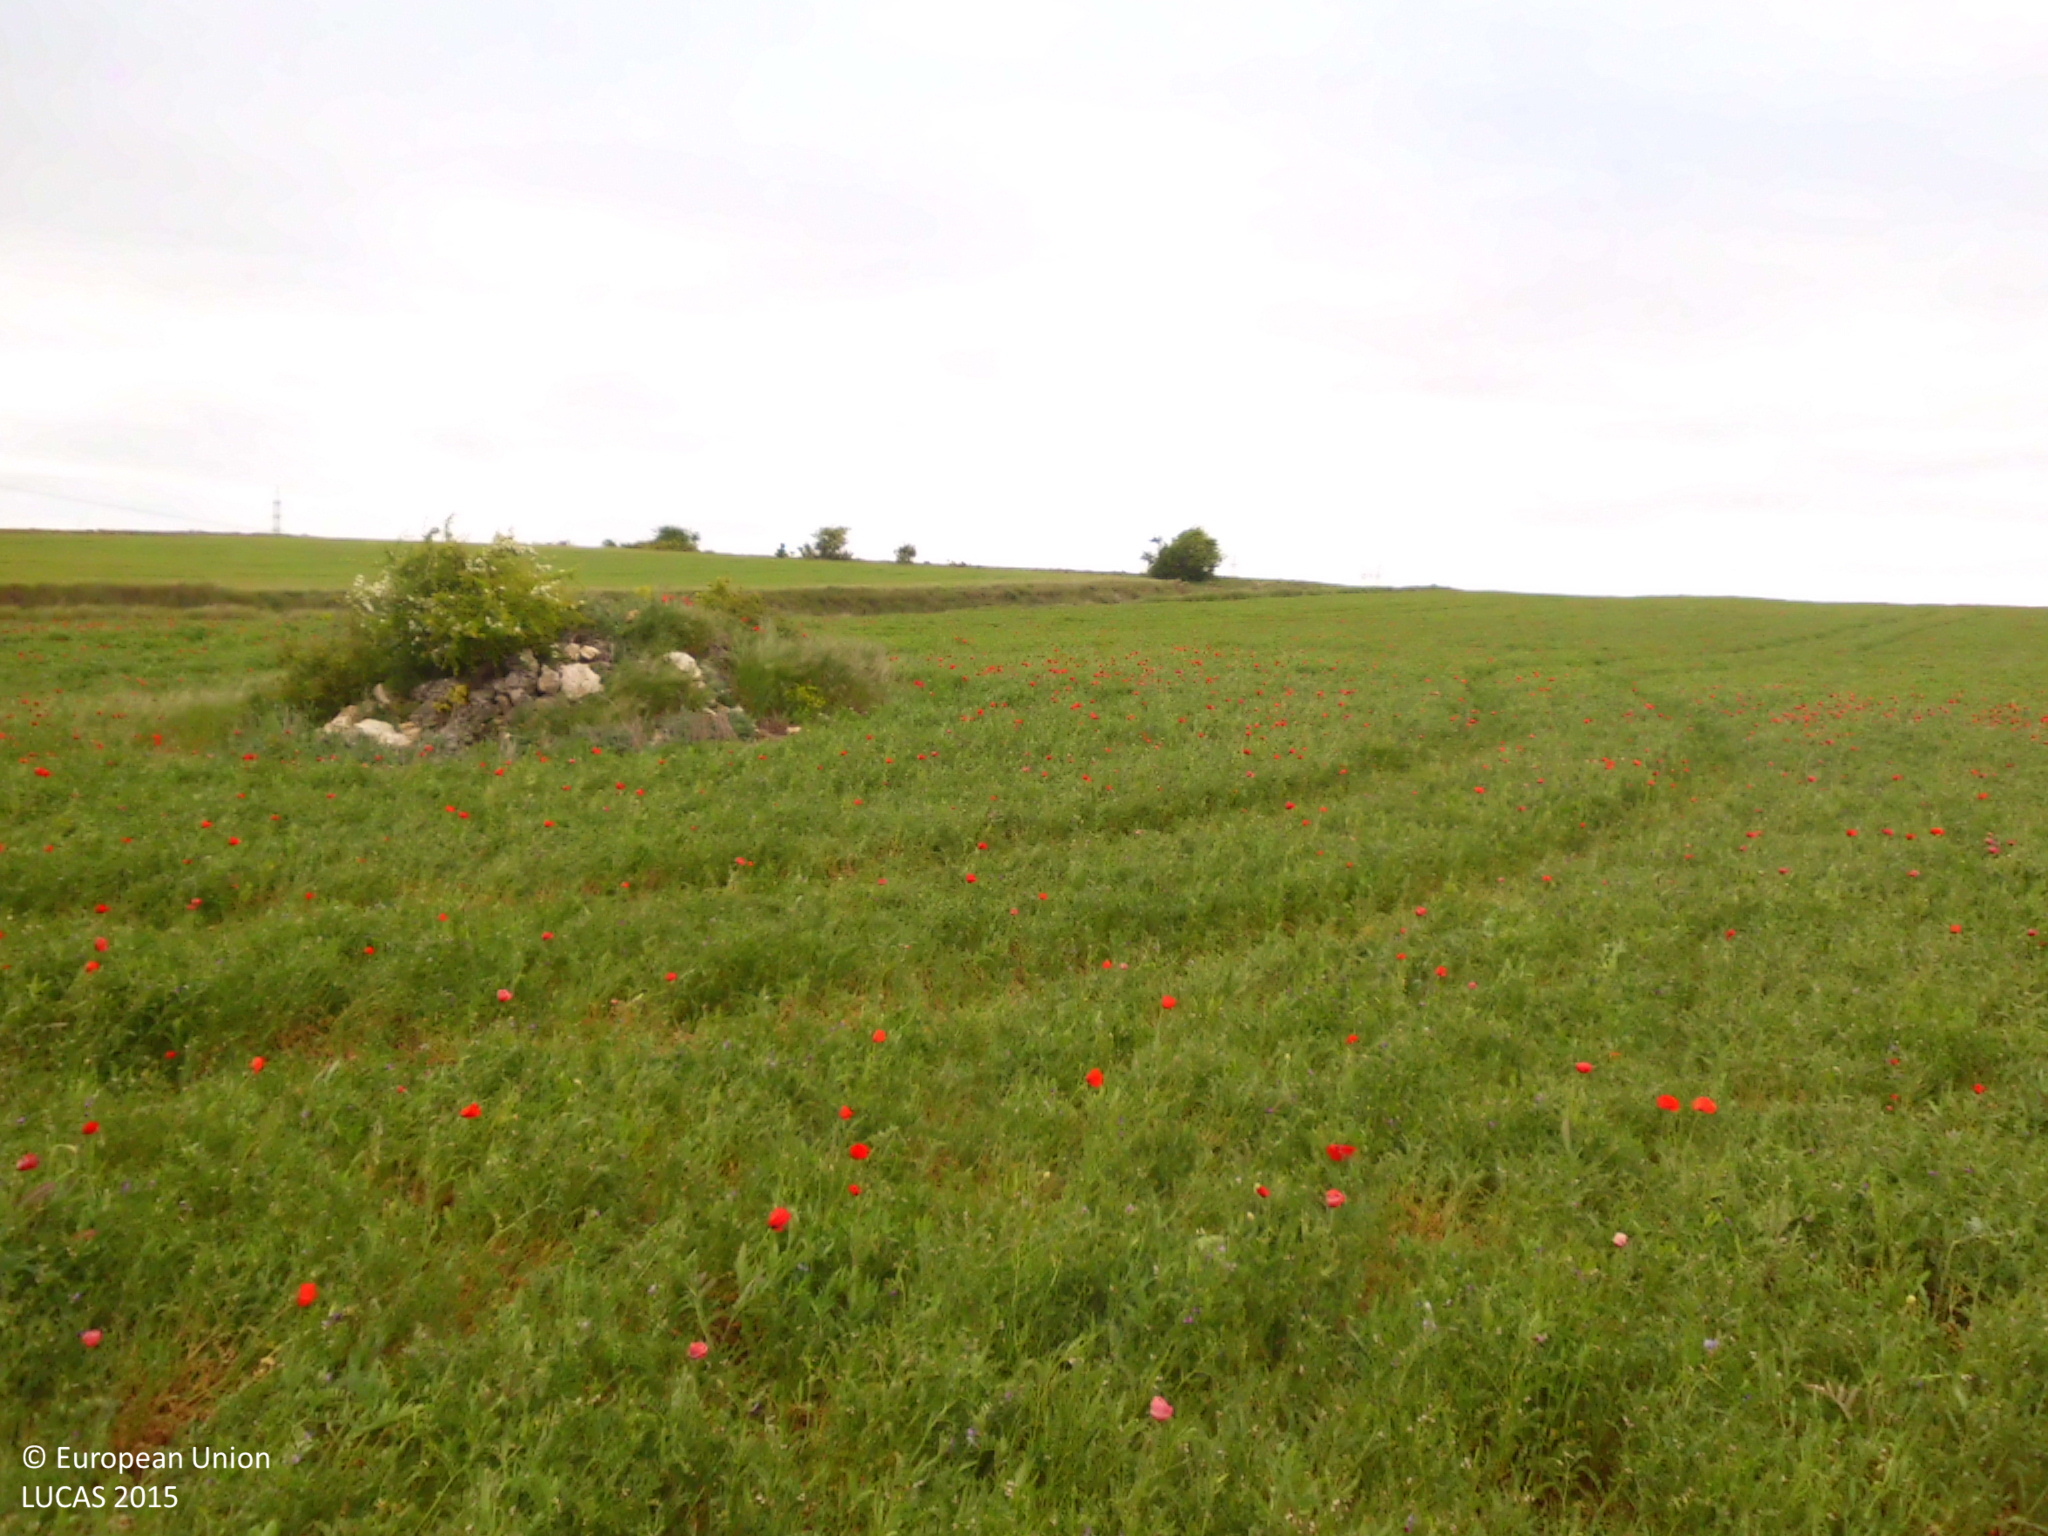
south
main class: Cropland
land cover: Dry pulses
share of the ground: > 75 %
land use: Agriculture (excluding fallow land and kitchen gardens)
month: May
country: ES
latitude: 42.3846
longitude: -3.7752
